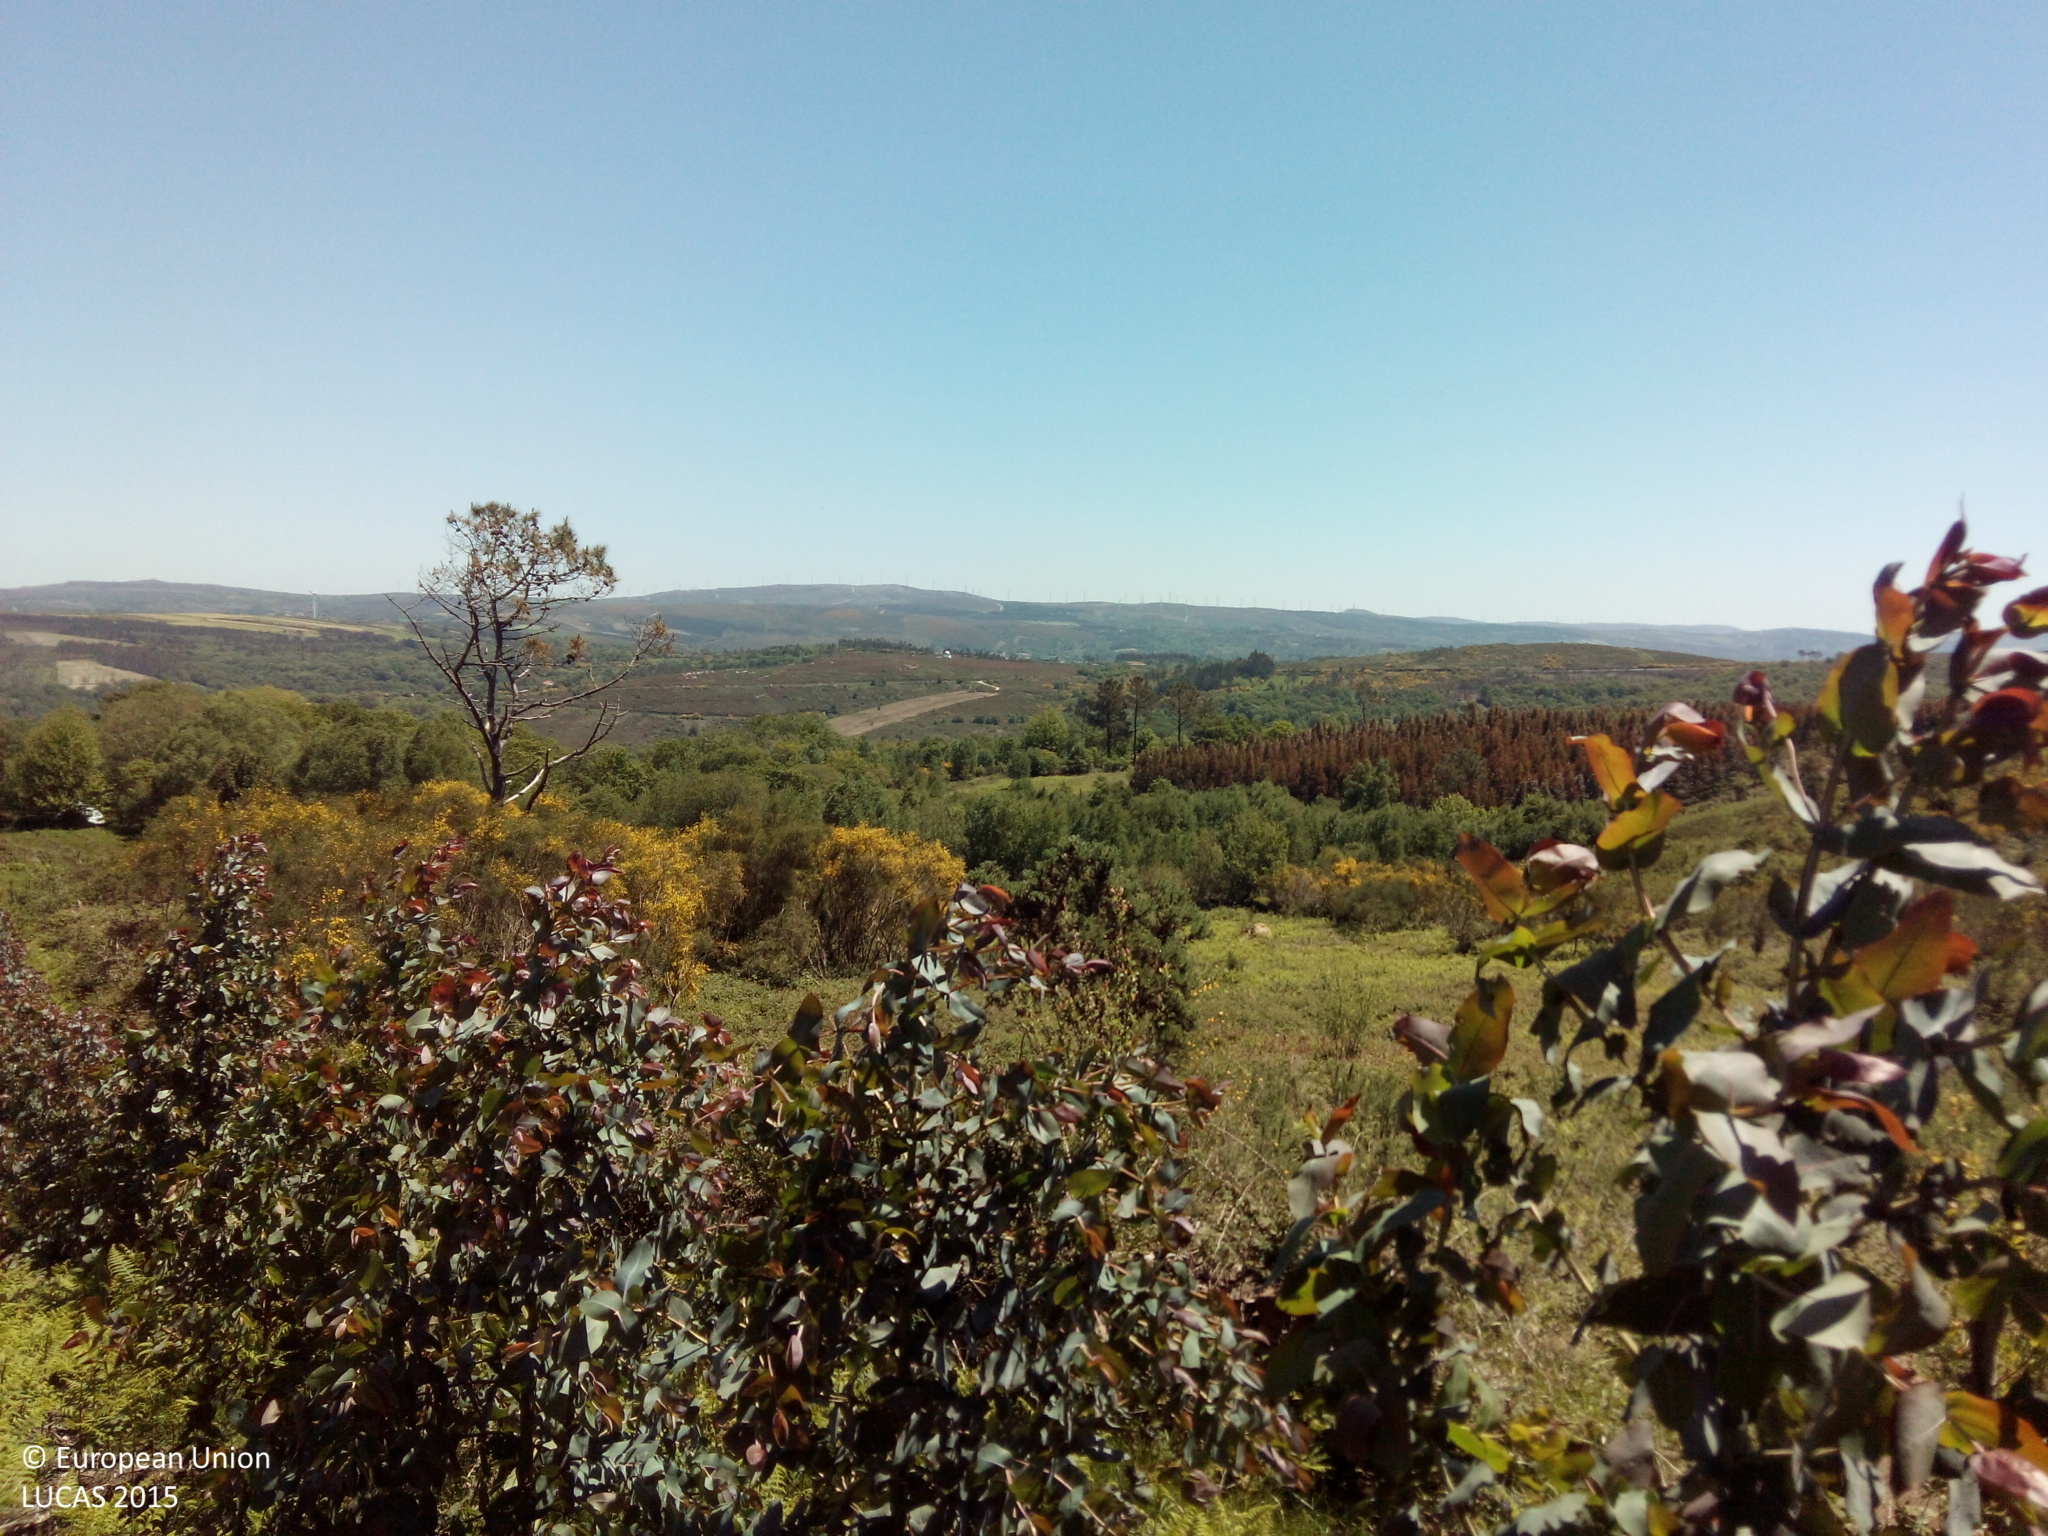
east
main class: Woodland
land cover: Broadleaved woodland
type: exotic forest
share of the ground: > 75 %
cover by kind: broadleaved forest trees 75 %, herbaceous plants 15 %, shrubs 10 %
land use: Forestry
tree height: < 5 m
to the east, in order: Broadleaved woodland; Fences; Shrubland without tree cover; Dry stone walls; Shrubland with sparse tree cover; Ditches and canals; Paved roads, cycling and walking lanes; Dry stone walls; Broadleaved woodland; Dry stone walls; Broadleaved woodland; Dry stone walls; Broadleaved woodland; Dry stone walls; Tracks; Dry stone walls; Grassland without tree/shrub cover; Broadleaved woodland
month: May
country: ES
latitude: 42.6146
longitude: -8.3949
